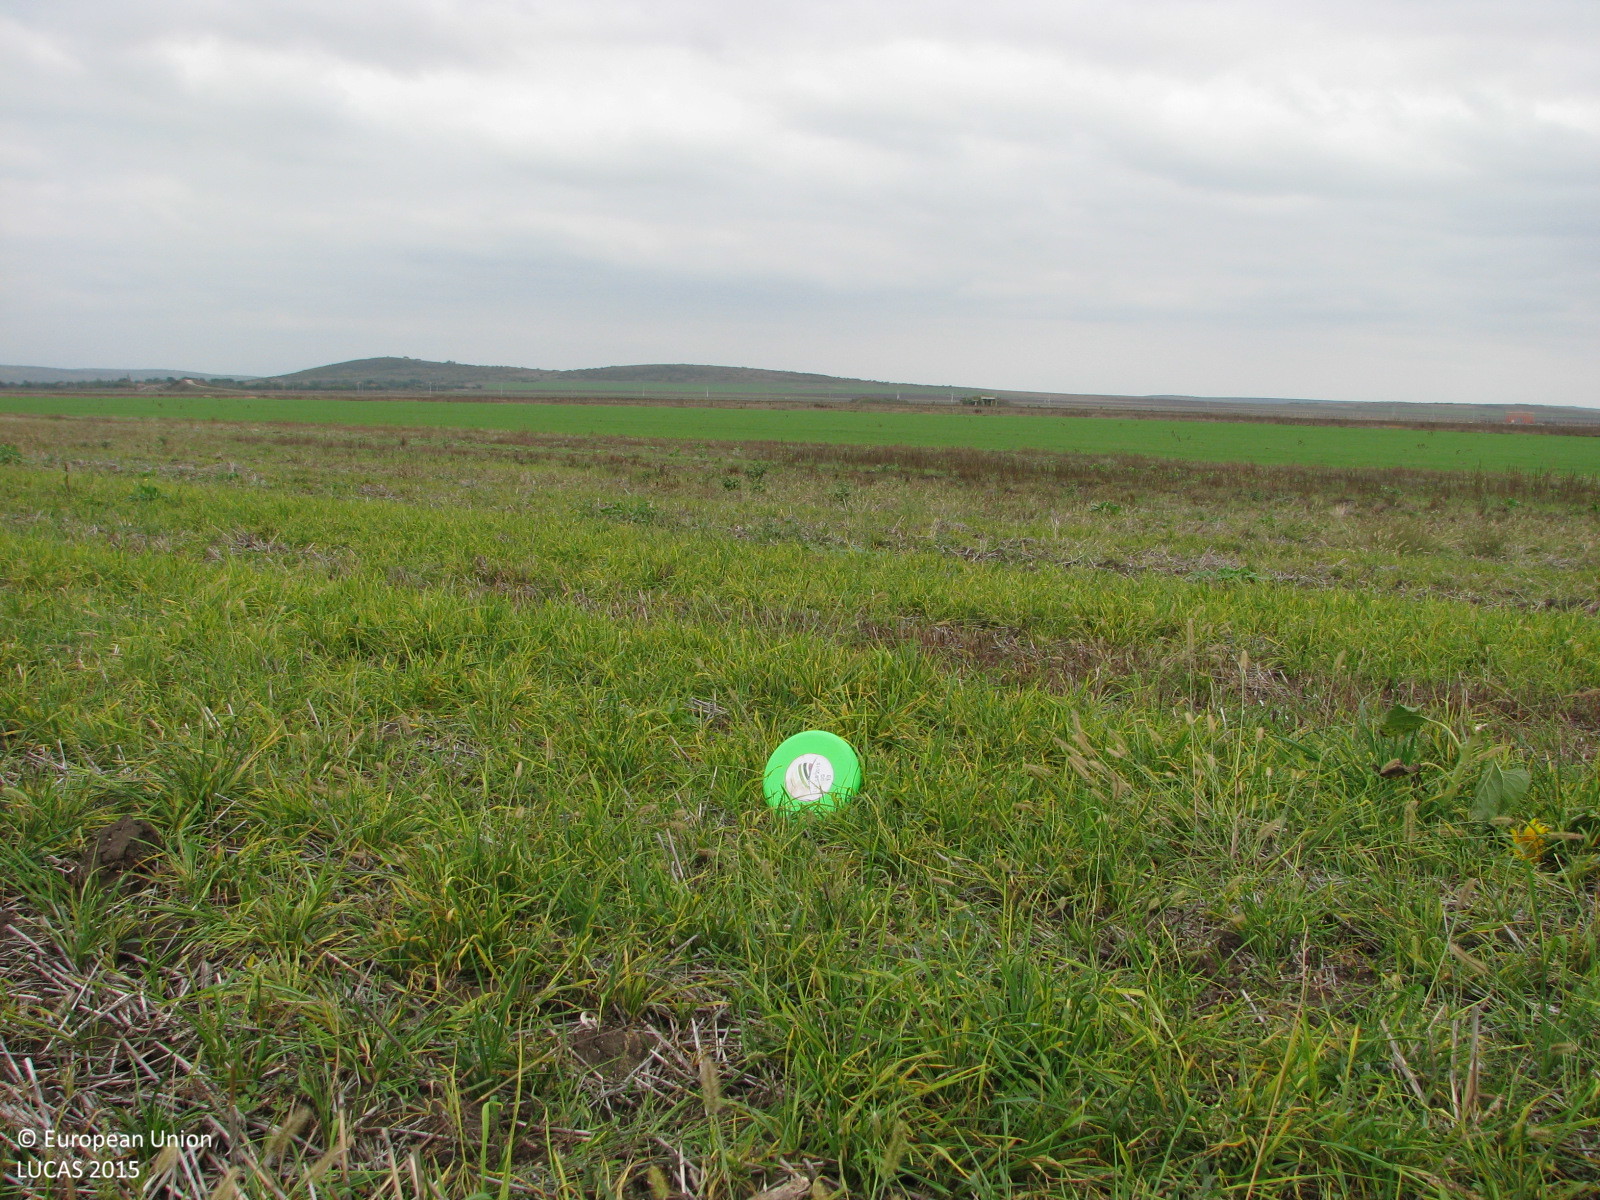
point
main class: Grassland
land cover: Spontaneously vegetated surfaces
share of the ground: > 75 %
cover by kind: herbaceous plants 100 %
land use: Agriculture (excluding fallow land and kitchen gardens)
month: October
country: BG
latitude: 42.4595
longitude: 26.3221
